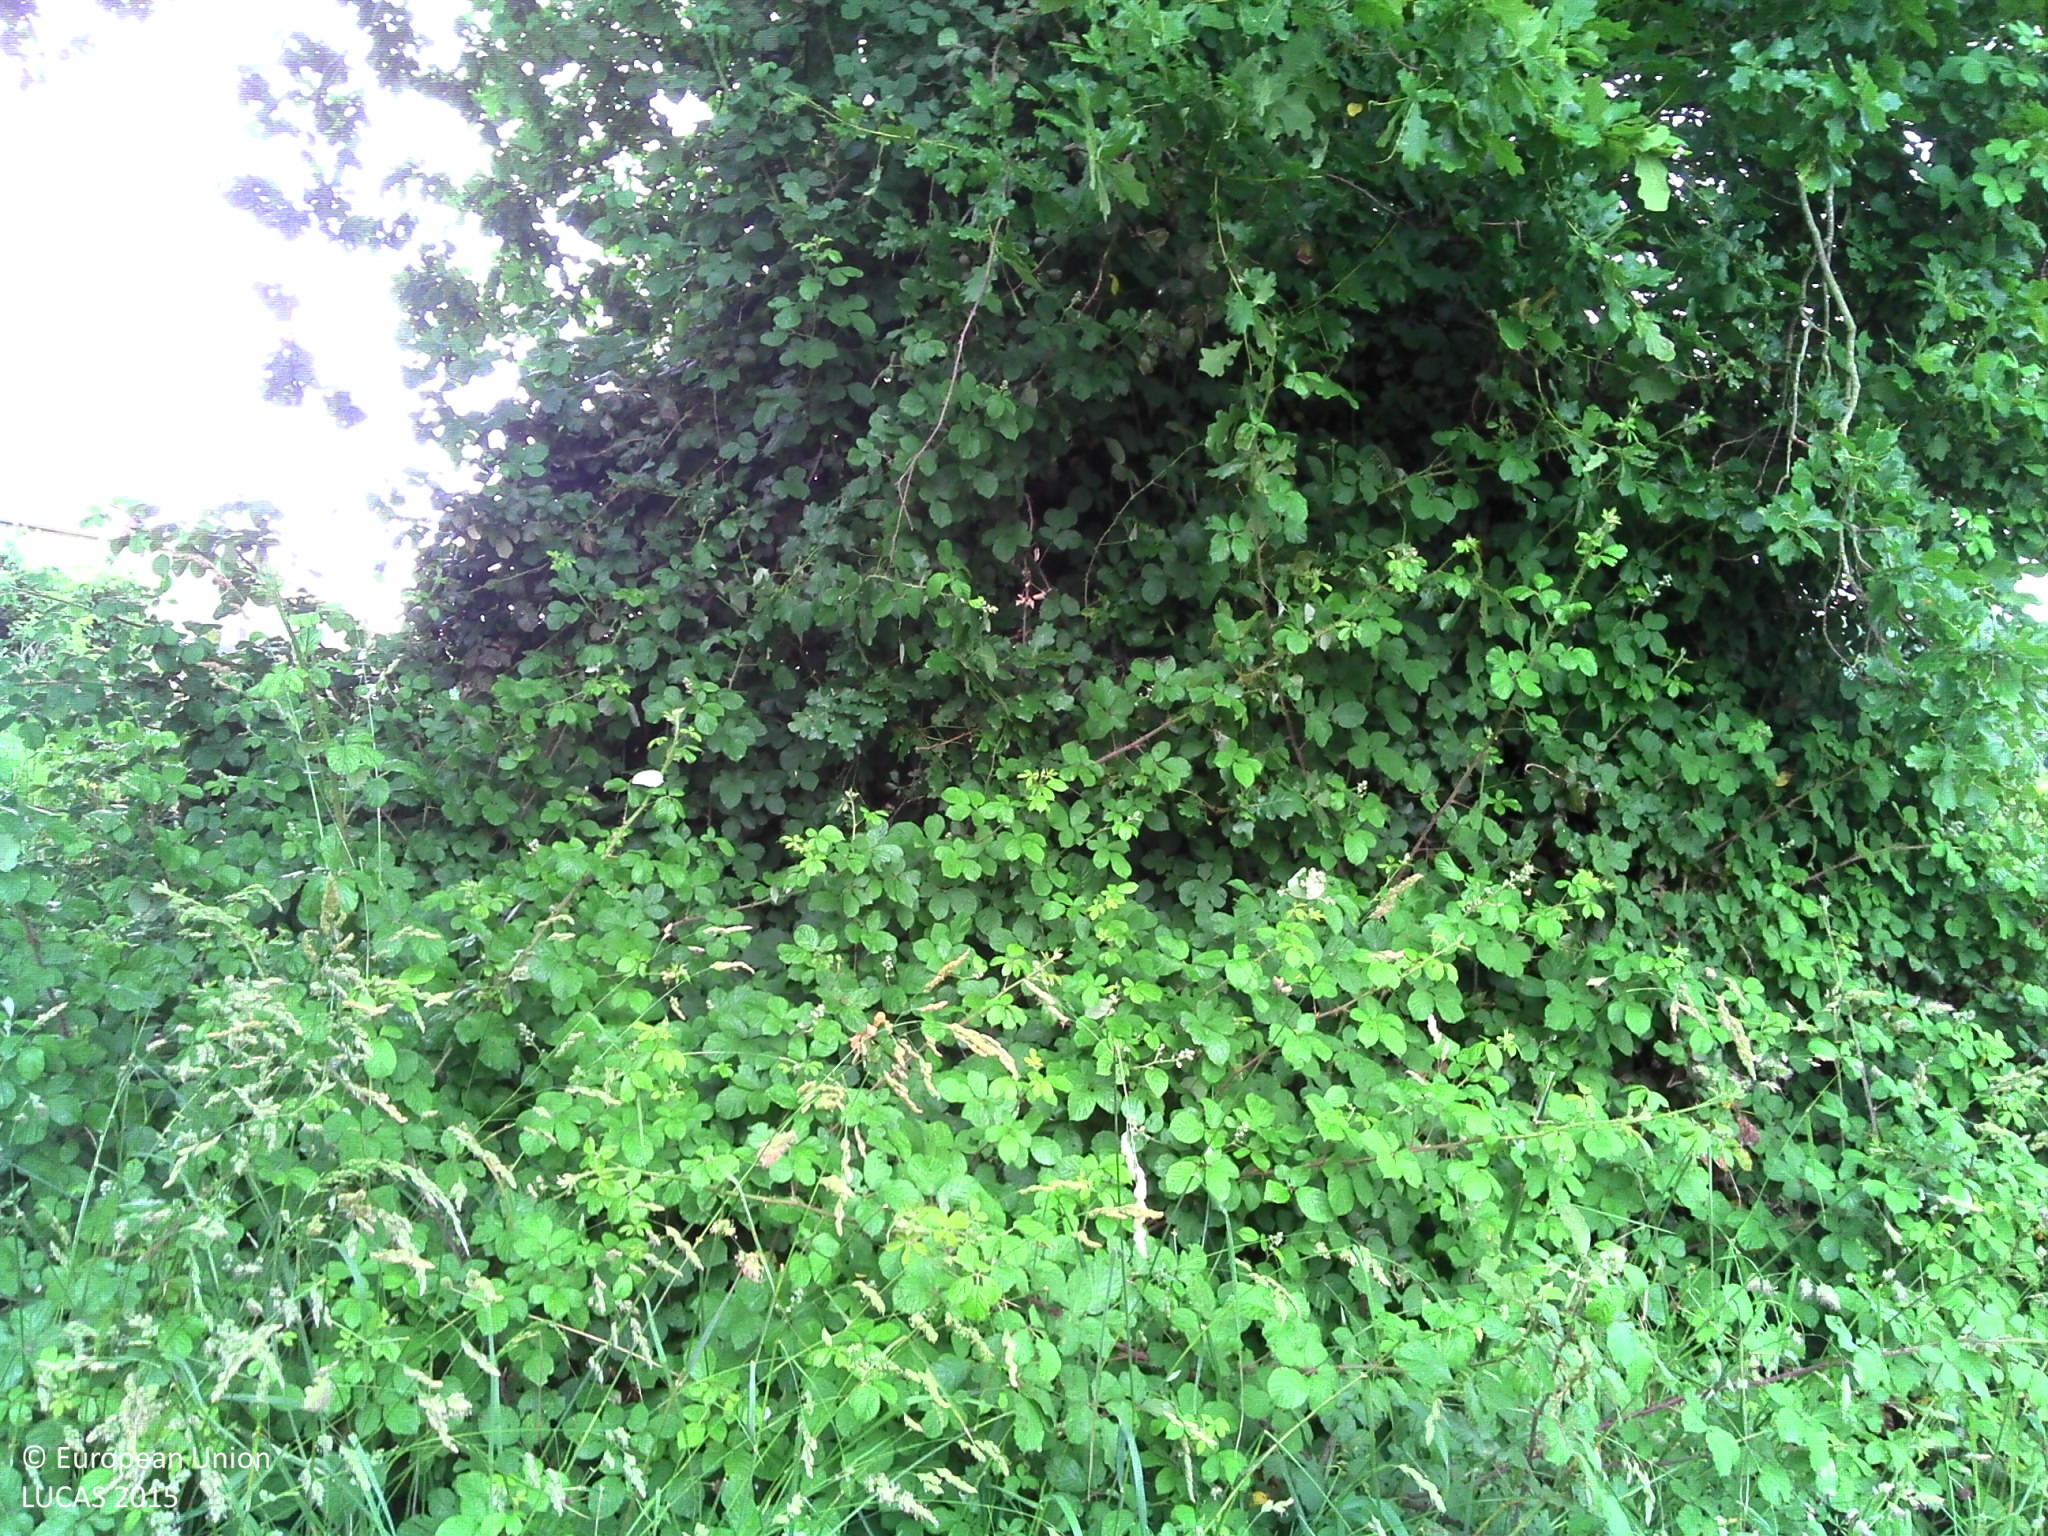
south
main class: Grassland
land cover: Grassland without tree/shrub cover
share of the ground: > 75 %
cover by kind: herbaceous plants 100 %
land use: Agriculture (excluding fallow land and kitchen gardens)
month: June
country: FR
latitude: 48.1148
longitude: -2.1301
